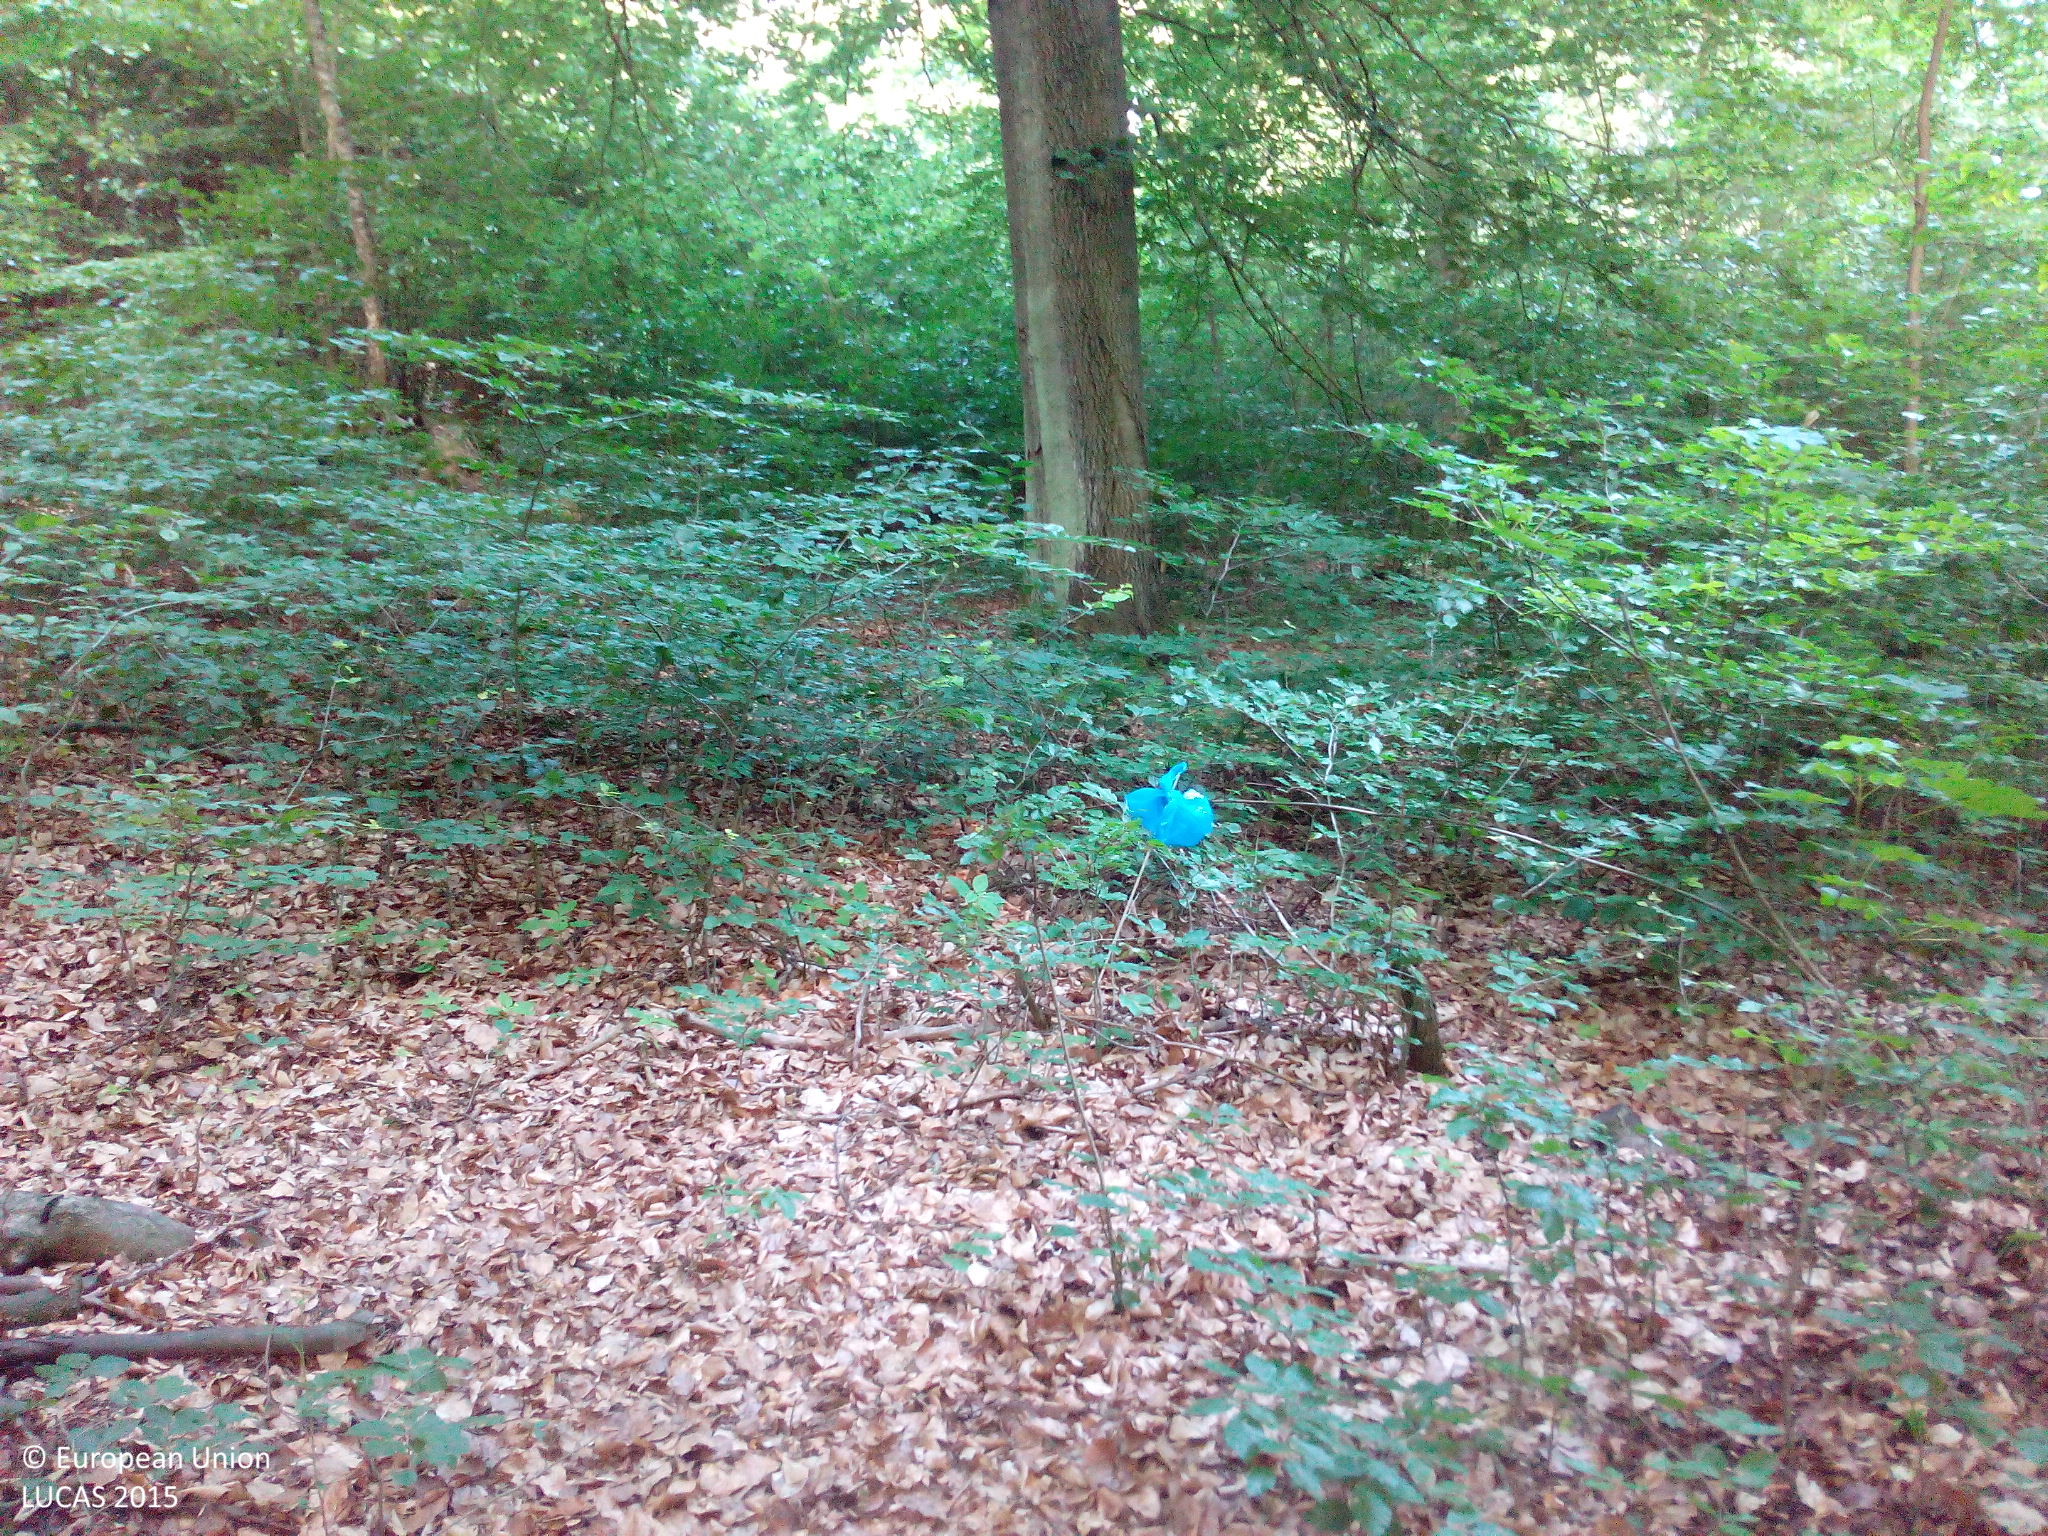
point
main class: Woodland
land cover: Broadleaved woodland
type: mesophytic deciduous forest
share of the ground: > 75 %
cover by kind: broadleaved forest trees 95 %, unconsolidated bare surface 5 %
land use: Forestry
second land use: Amenities, museums, leisure
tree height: > 5 m
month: June
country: DE
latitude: 52.1193
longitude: 12.4094
